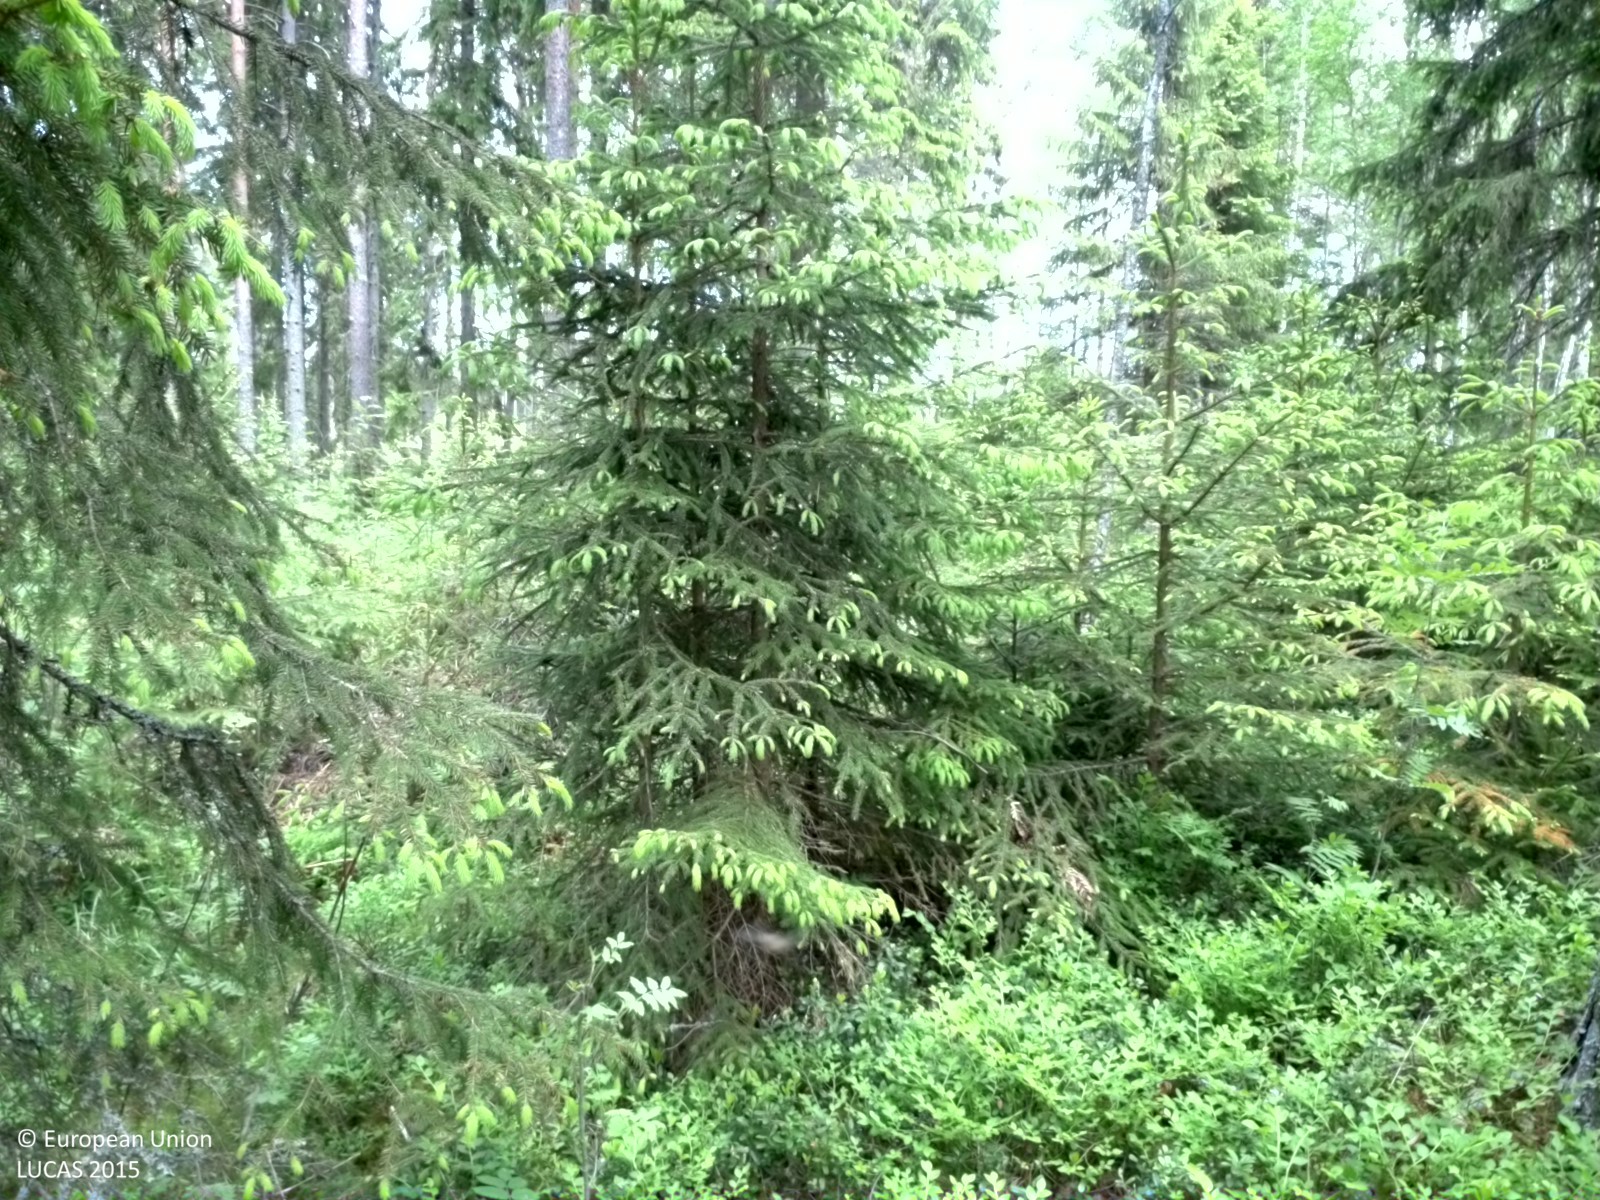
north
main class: Woodland
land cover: Other coniferous woodland
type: boreal forest
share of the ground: 50 - 75 %
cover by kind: coniferous forest trees 50 %, broadleaved forest trees 15 %, shrubs 15 %, herbaceous plants 5 %, lichens and mosses 5 %, consolidated bare surface 5 %
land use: Forestry
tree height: > 5 m
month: June
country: SE
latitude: 60.3287
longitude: 17.0715
